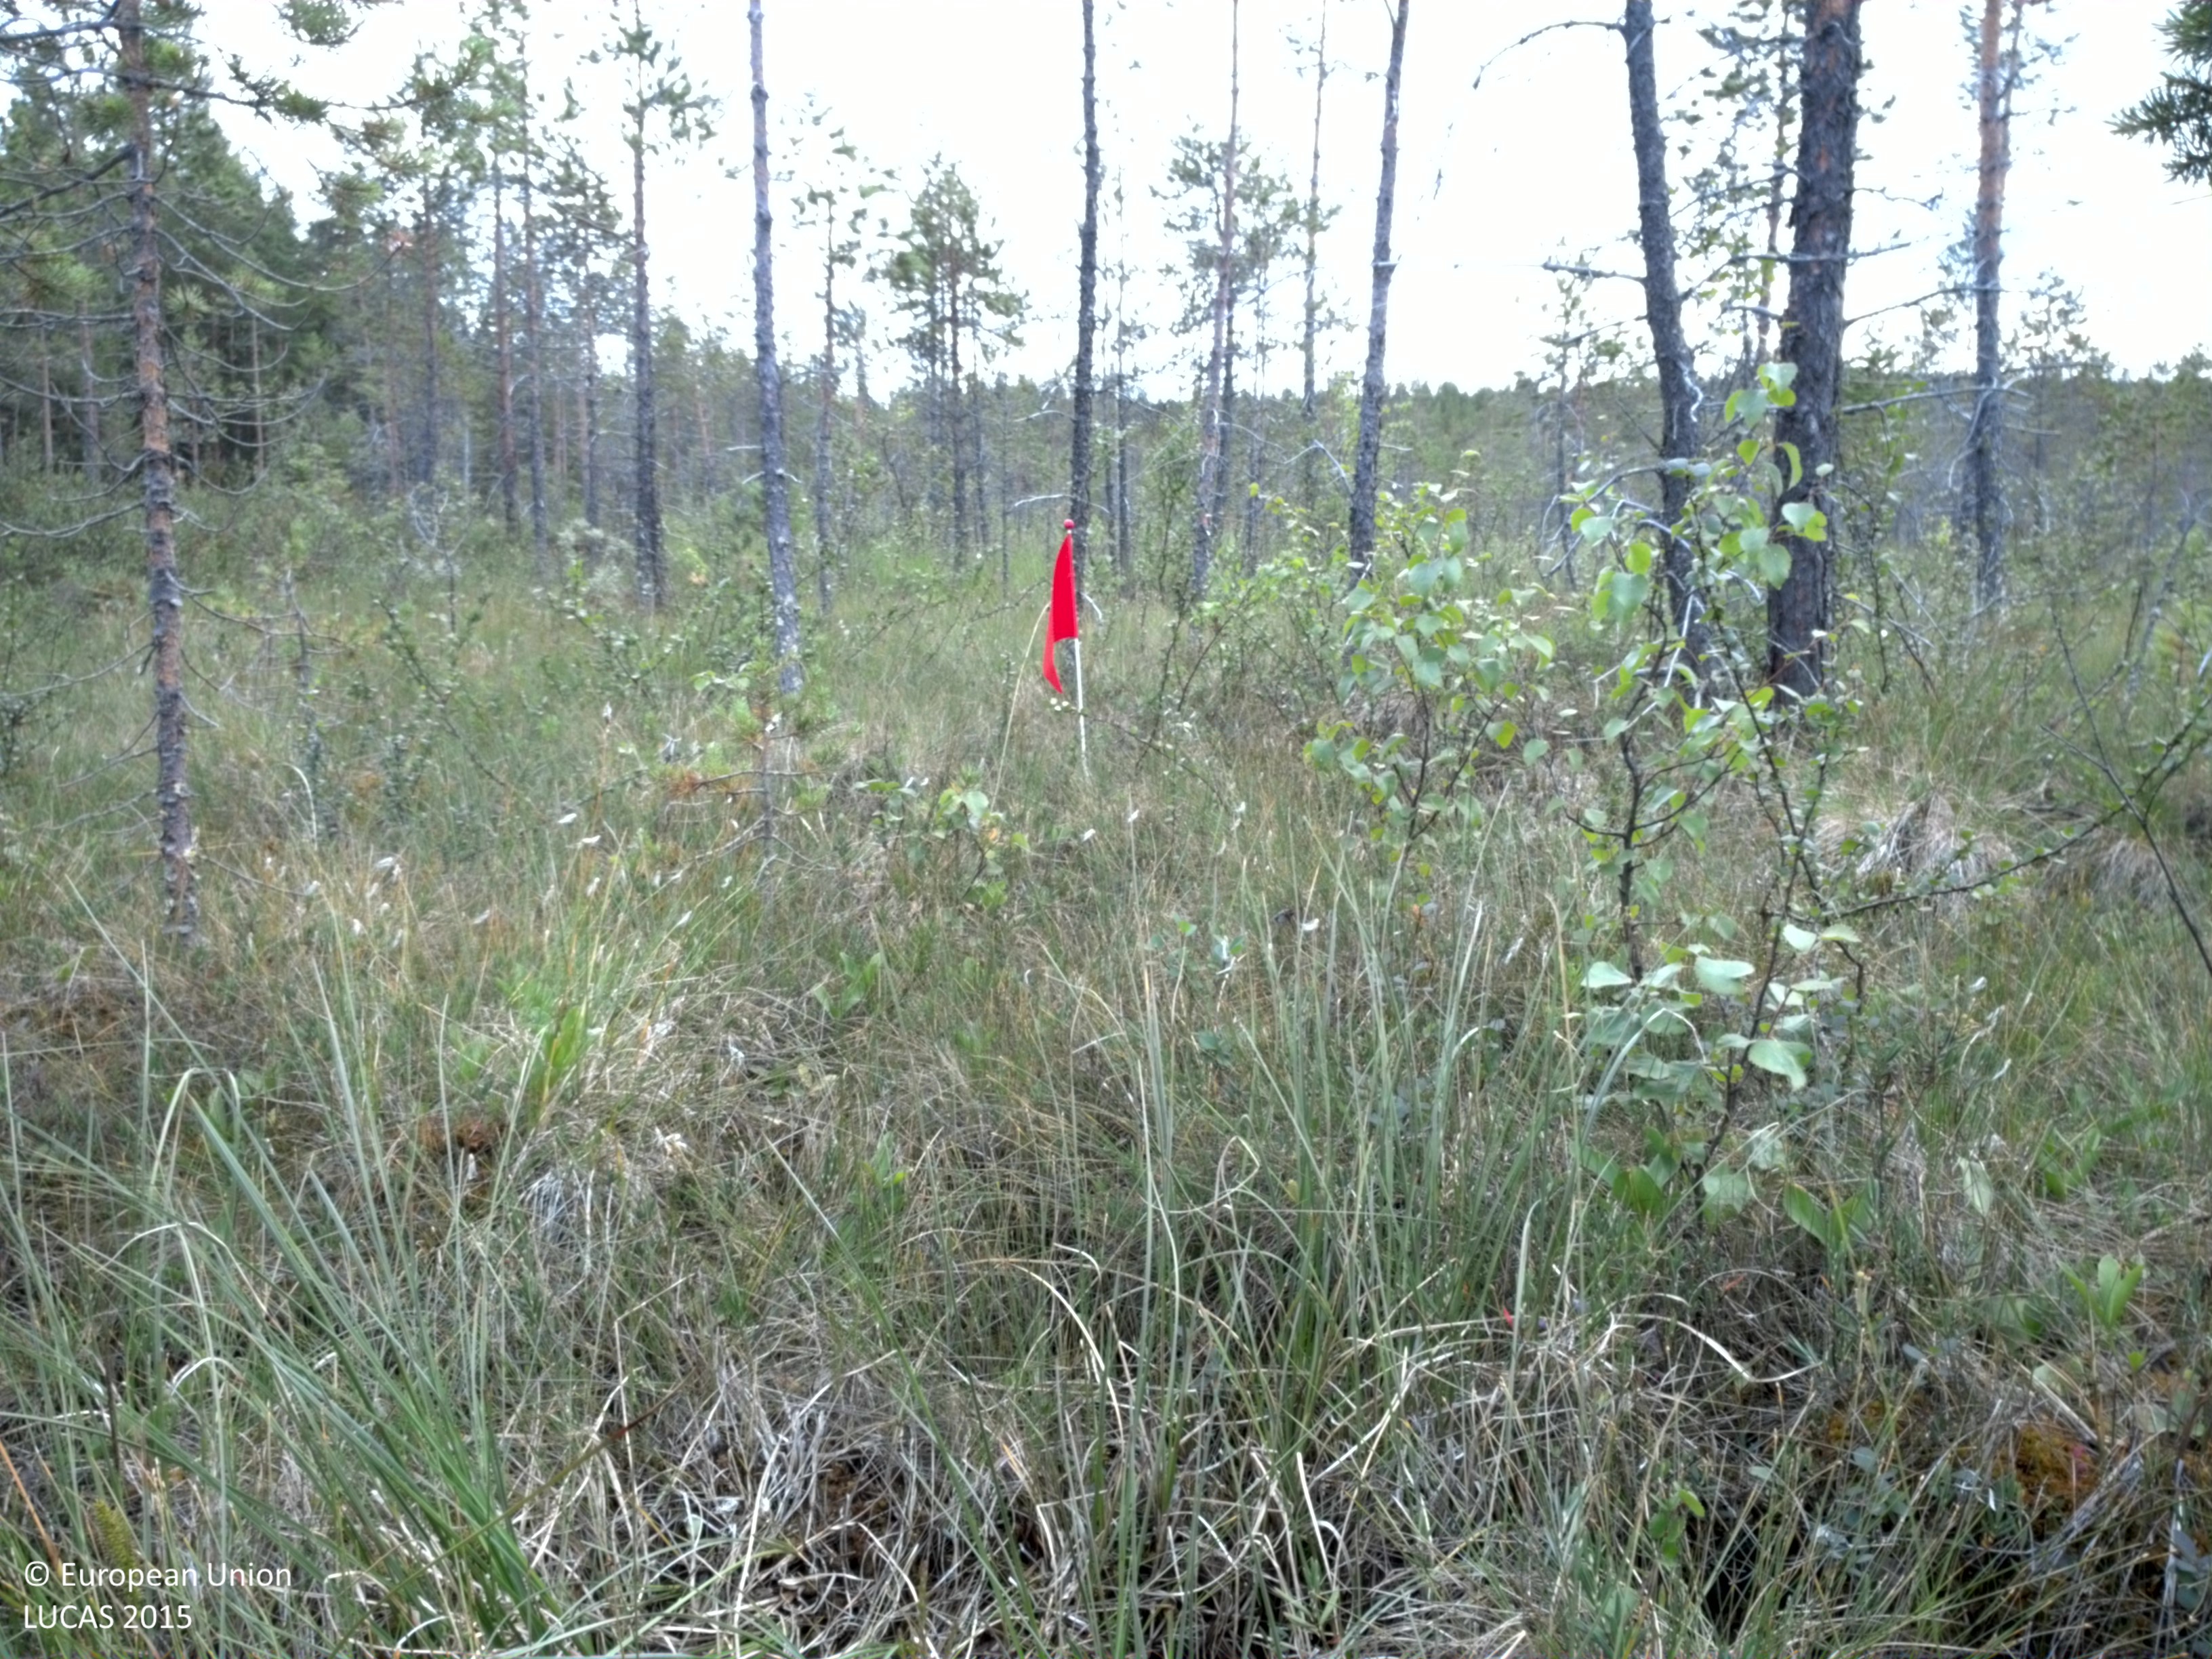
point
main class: Woodland
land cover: Pine dominated coniferous woodland
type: mire and swamp forests
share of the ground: 10 - 25 %
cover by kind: herbaceous plants 50 %, shrubs 30 %, coniferous forest trees 15 %, lichens and mosses 5 %
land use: Semi-natural and natural areas not in use
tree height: > 5 m
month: August
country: SE
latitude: 66.5678
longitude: 19.9361
